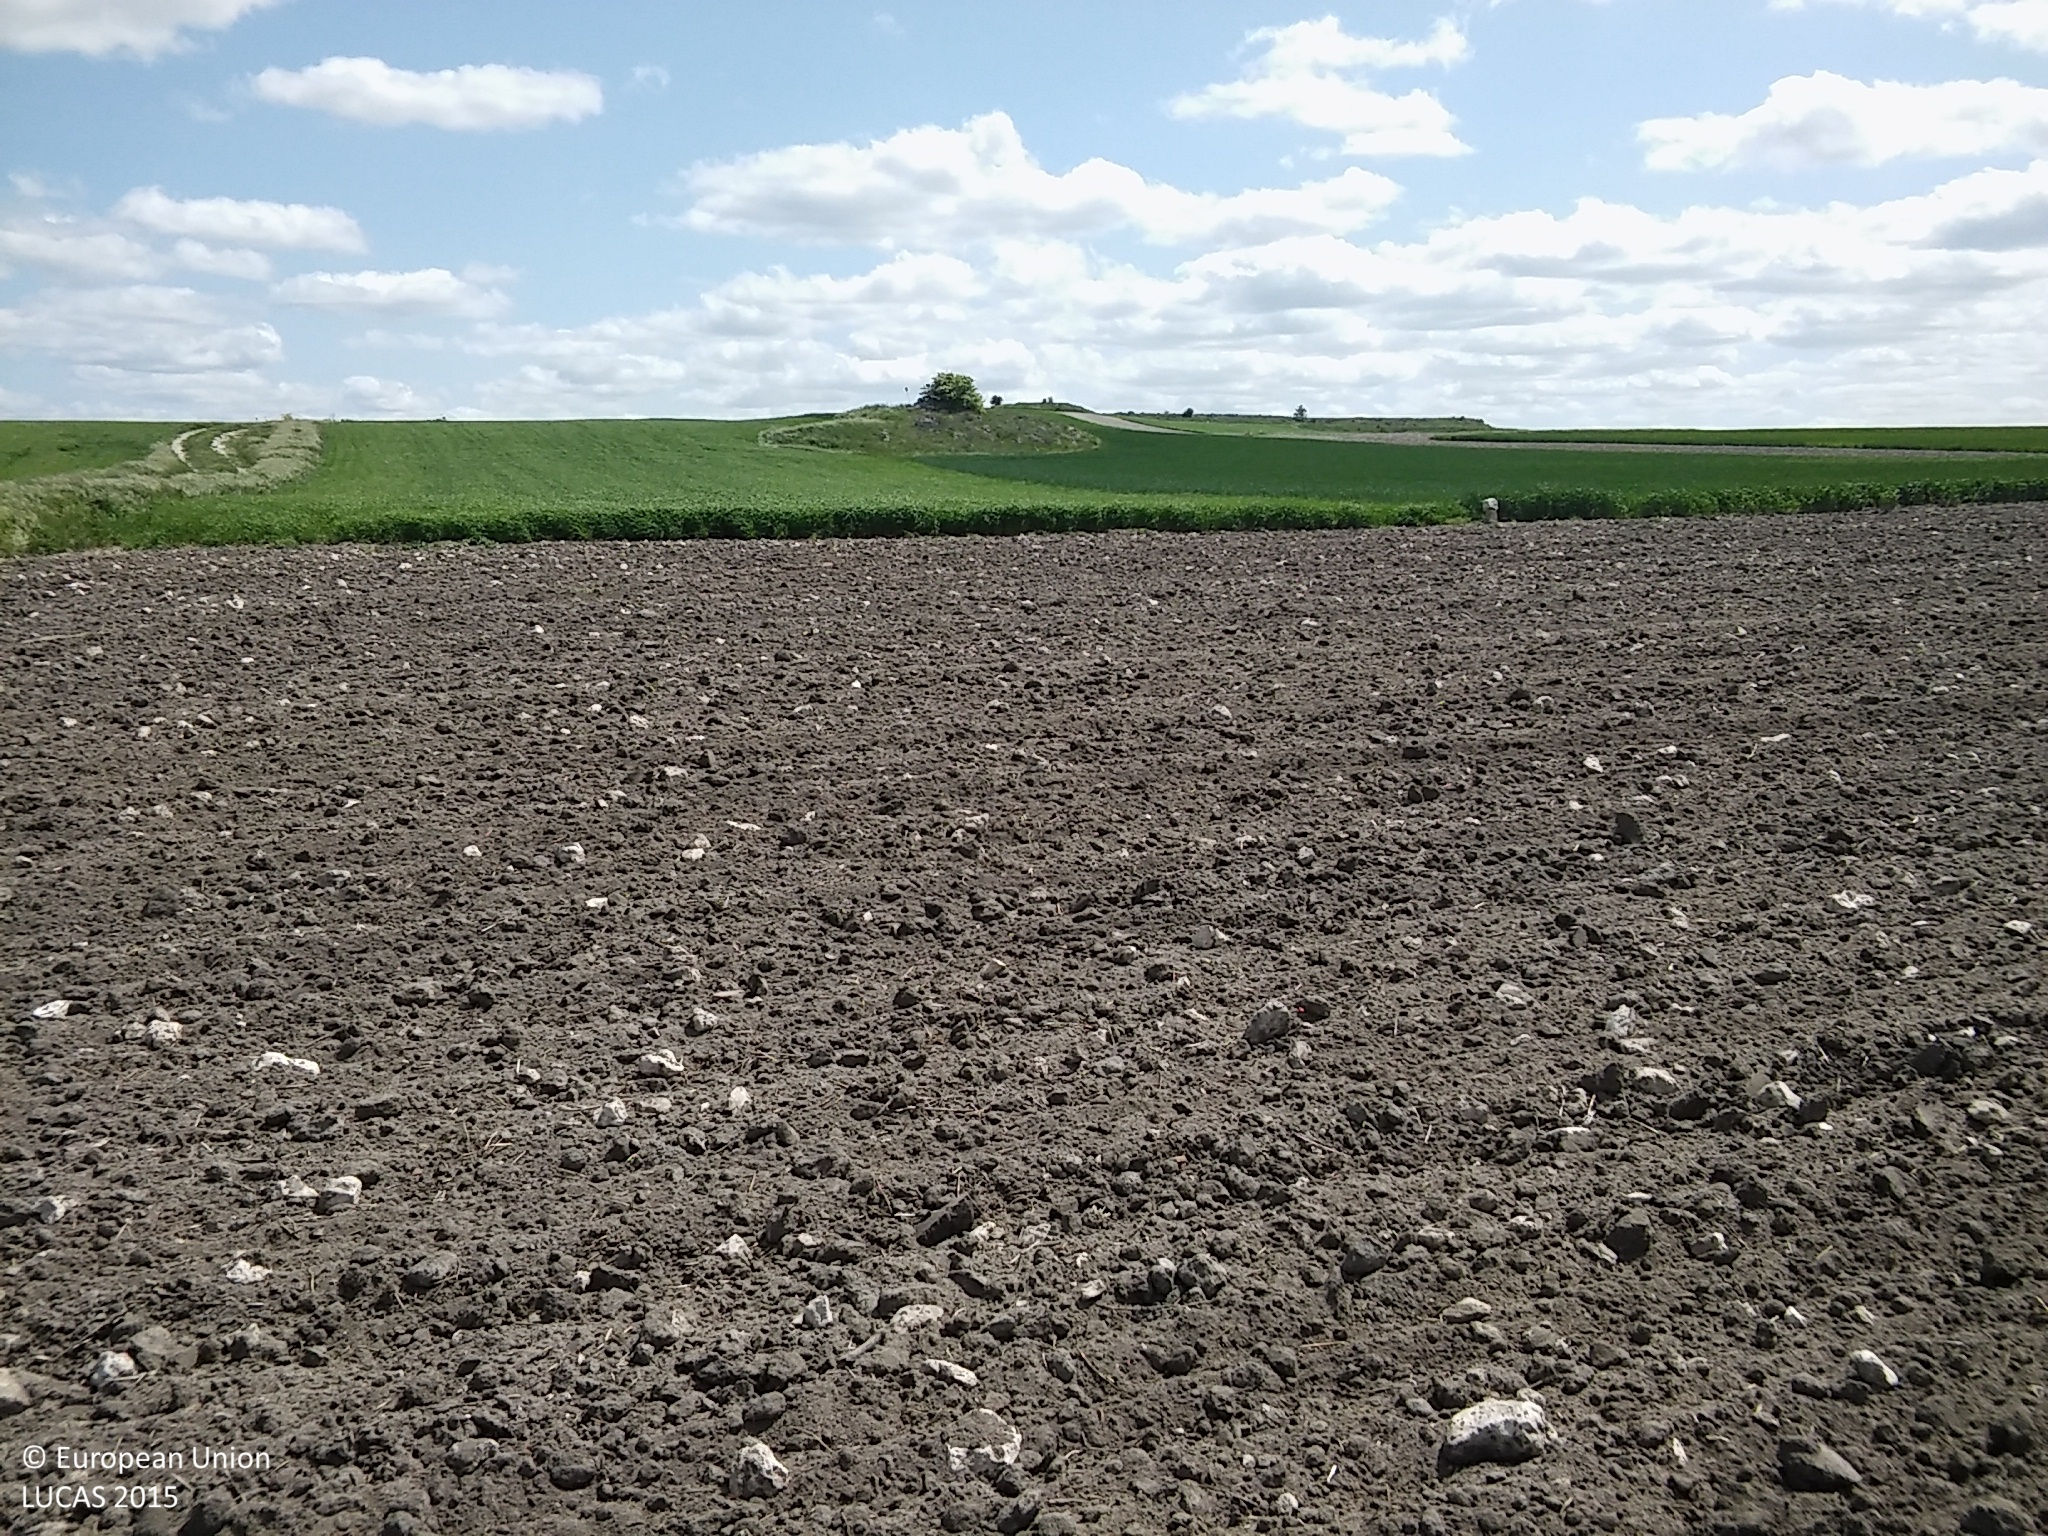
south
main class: Cropland
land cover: Sunflower
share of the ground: < 10 %
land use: Agriculture (excluding fallow land and kitchen gardens)
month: May
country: ES
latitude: 41.3864
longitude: -4.1070
